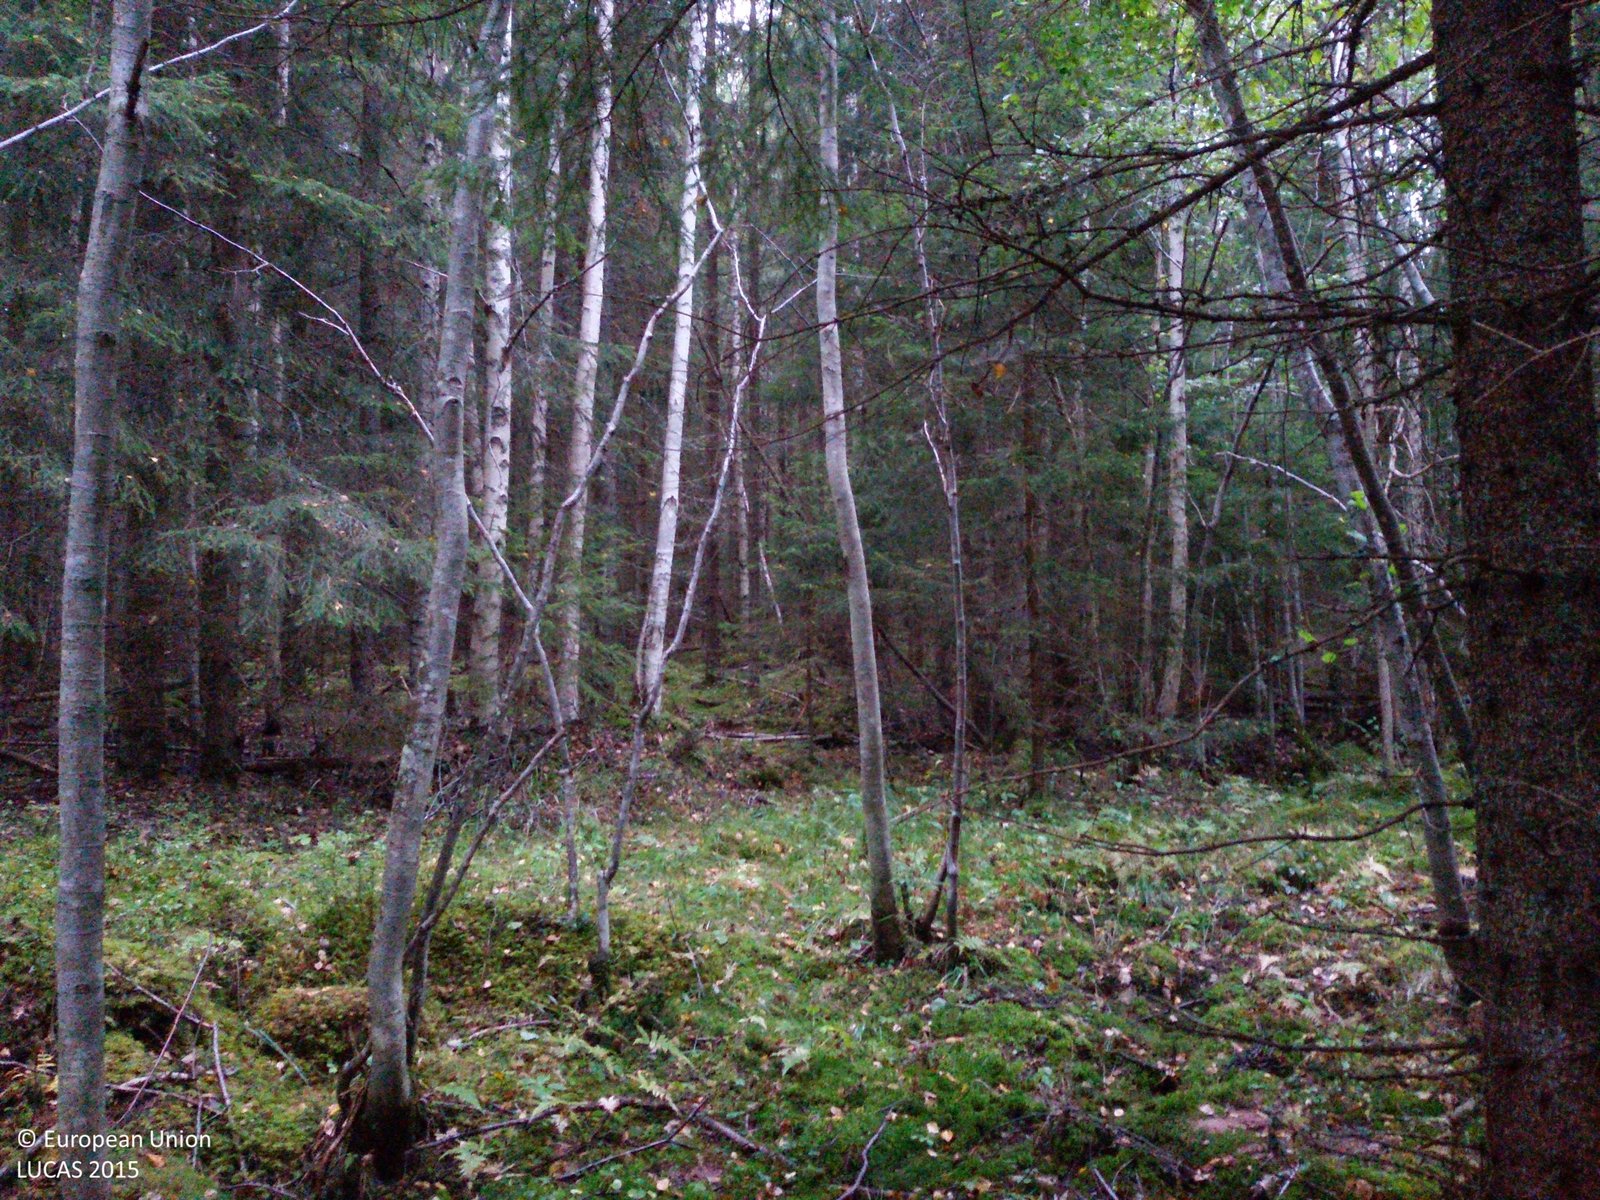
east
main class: Woodland
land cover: Spruce dominated mixed woodland
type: boreal forest
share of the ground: > 75 %
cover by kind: coniferous forest trees 55 %, broadleaved forest trees 35 %, herbaceous plants 10 %
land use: Forestry
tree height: > 5 m
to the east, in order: Spruce dominated mixed woodland; Rivers and streams; Spruce dominated mixed woodland; Spruce dominated coniferous woodland; Rivers and streams; Spruce dominated coniferous woodland; Paved roads, cycling and walking lanes; Spruce dominated mixed woodland
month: September
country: SE
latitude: 60.7097
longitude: 14.8797
